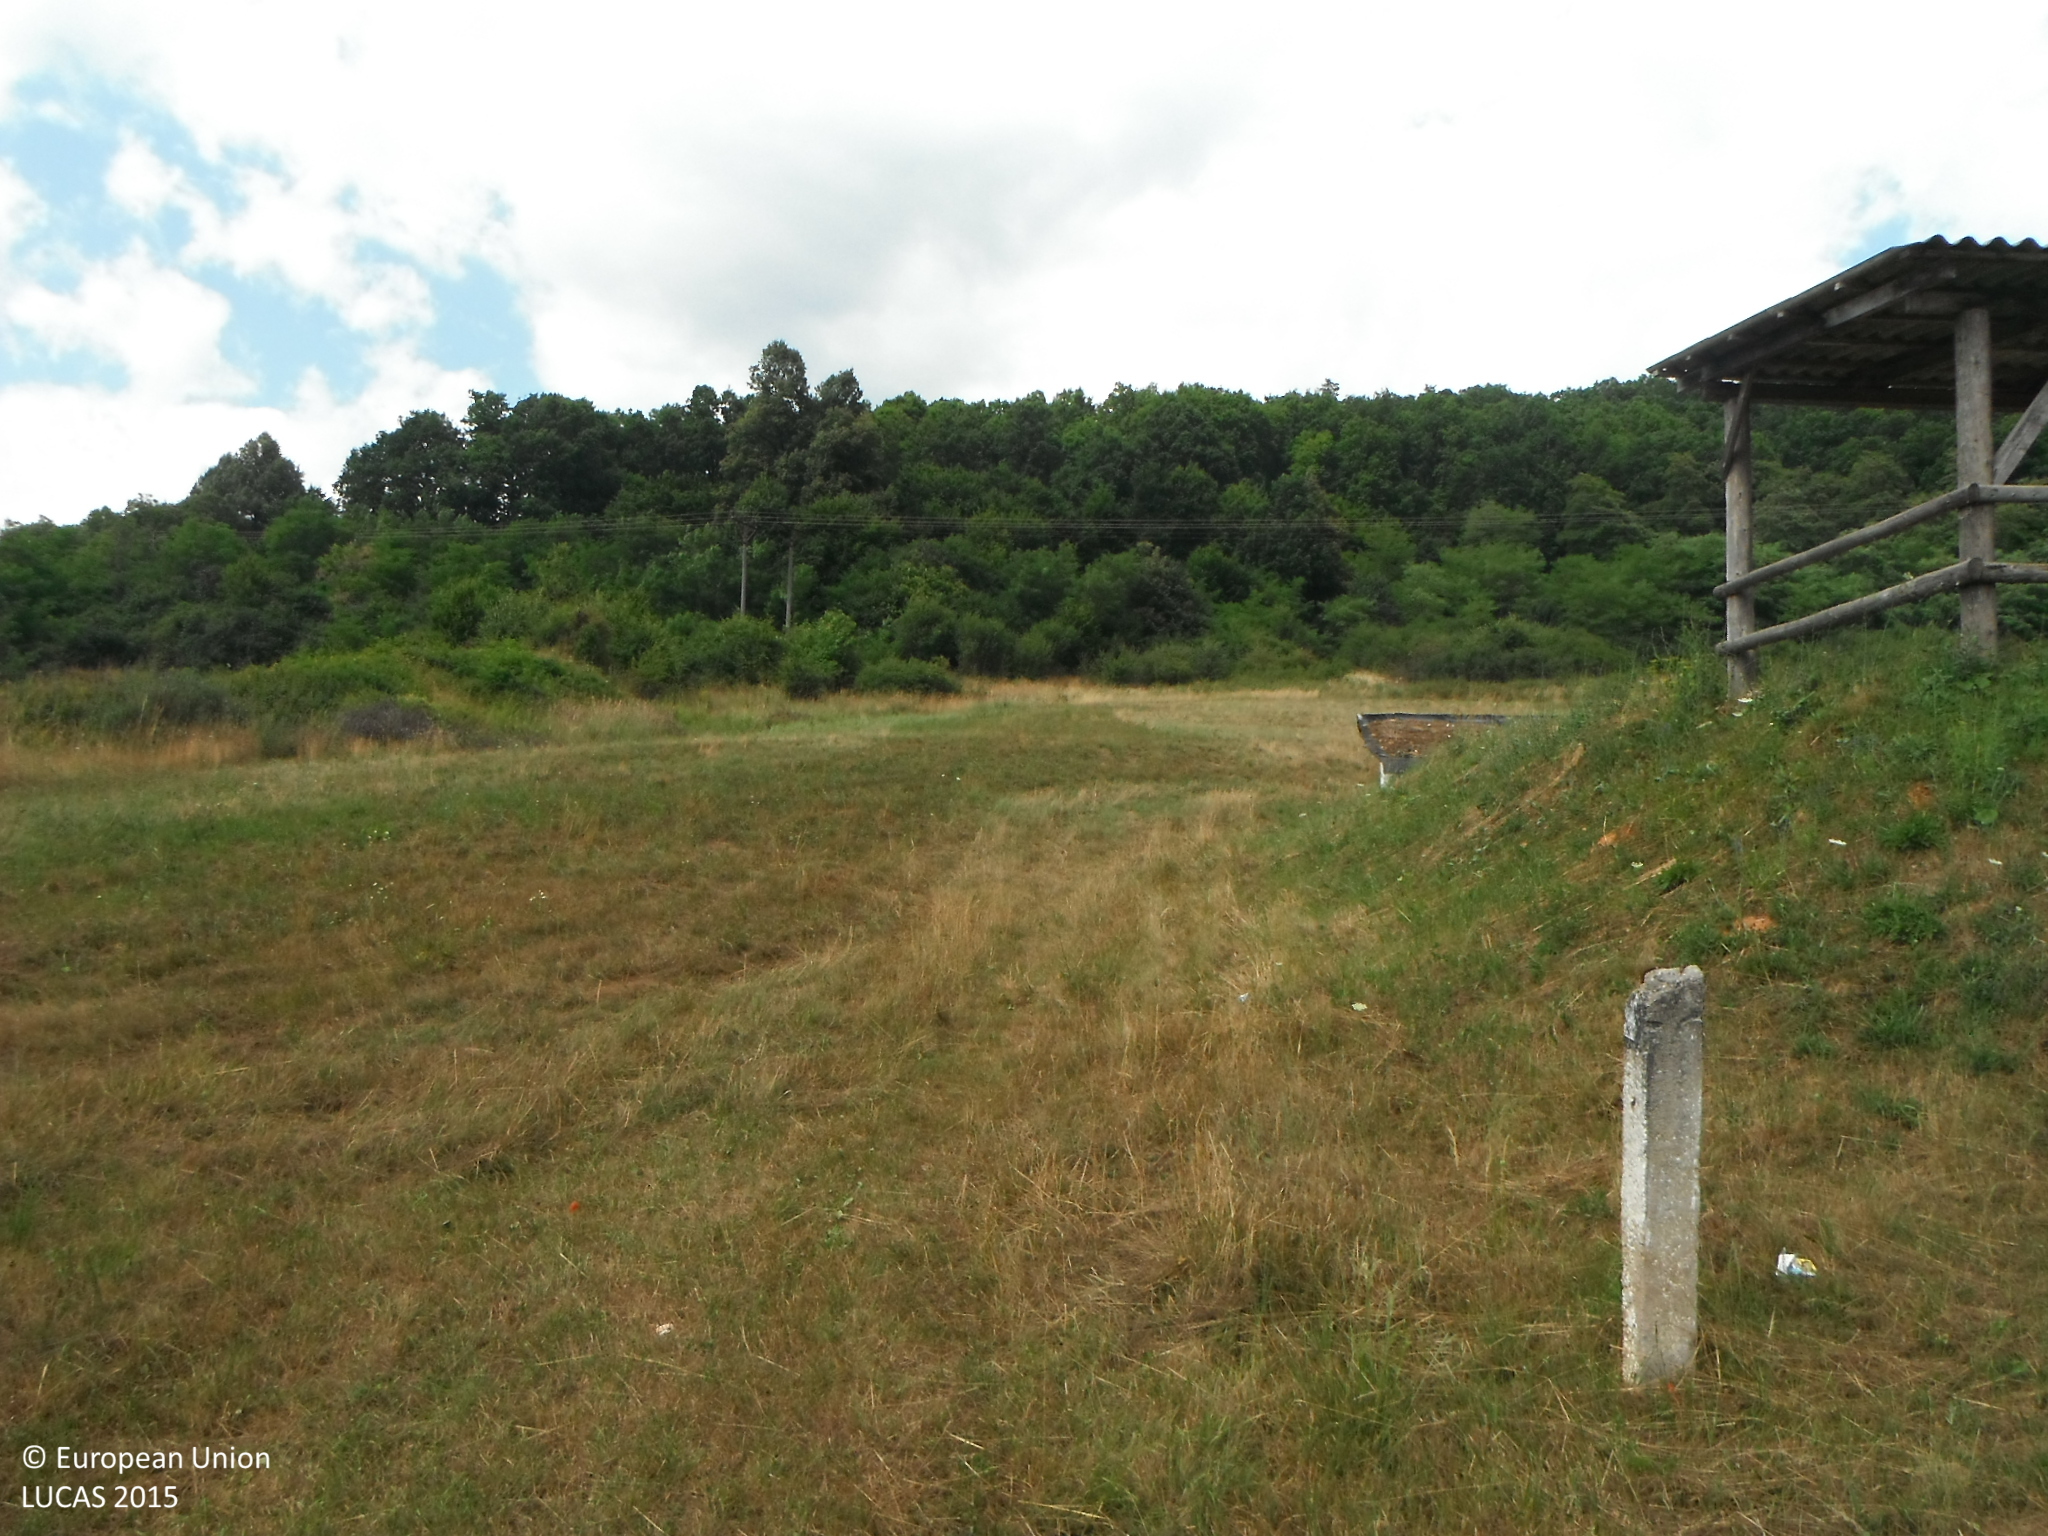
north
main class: Grassland
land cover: Grassland without tree/shrub cover
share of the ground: > 75 %
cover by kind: herbaceous plants 100 %
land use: Amenities, museums, leisure
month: July
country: SK
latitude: 48.6332
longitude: 20.2502
